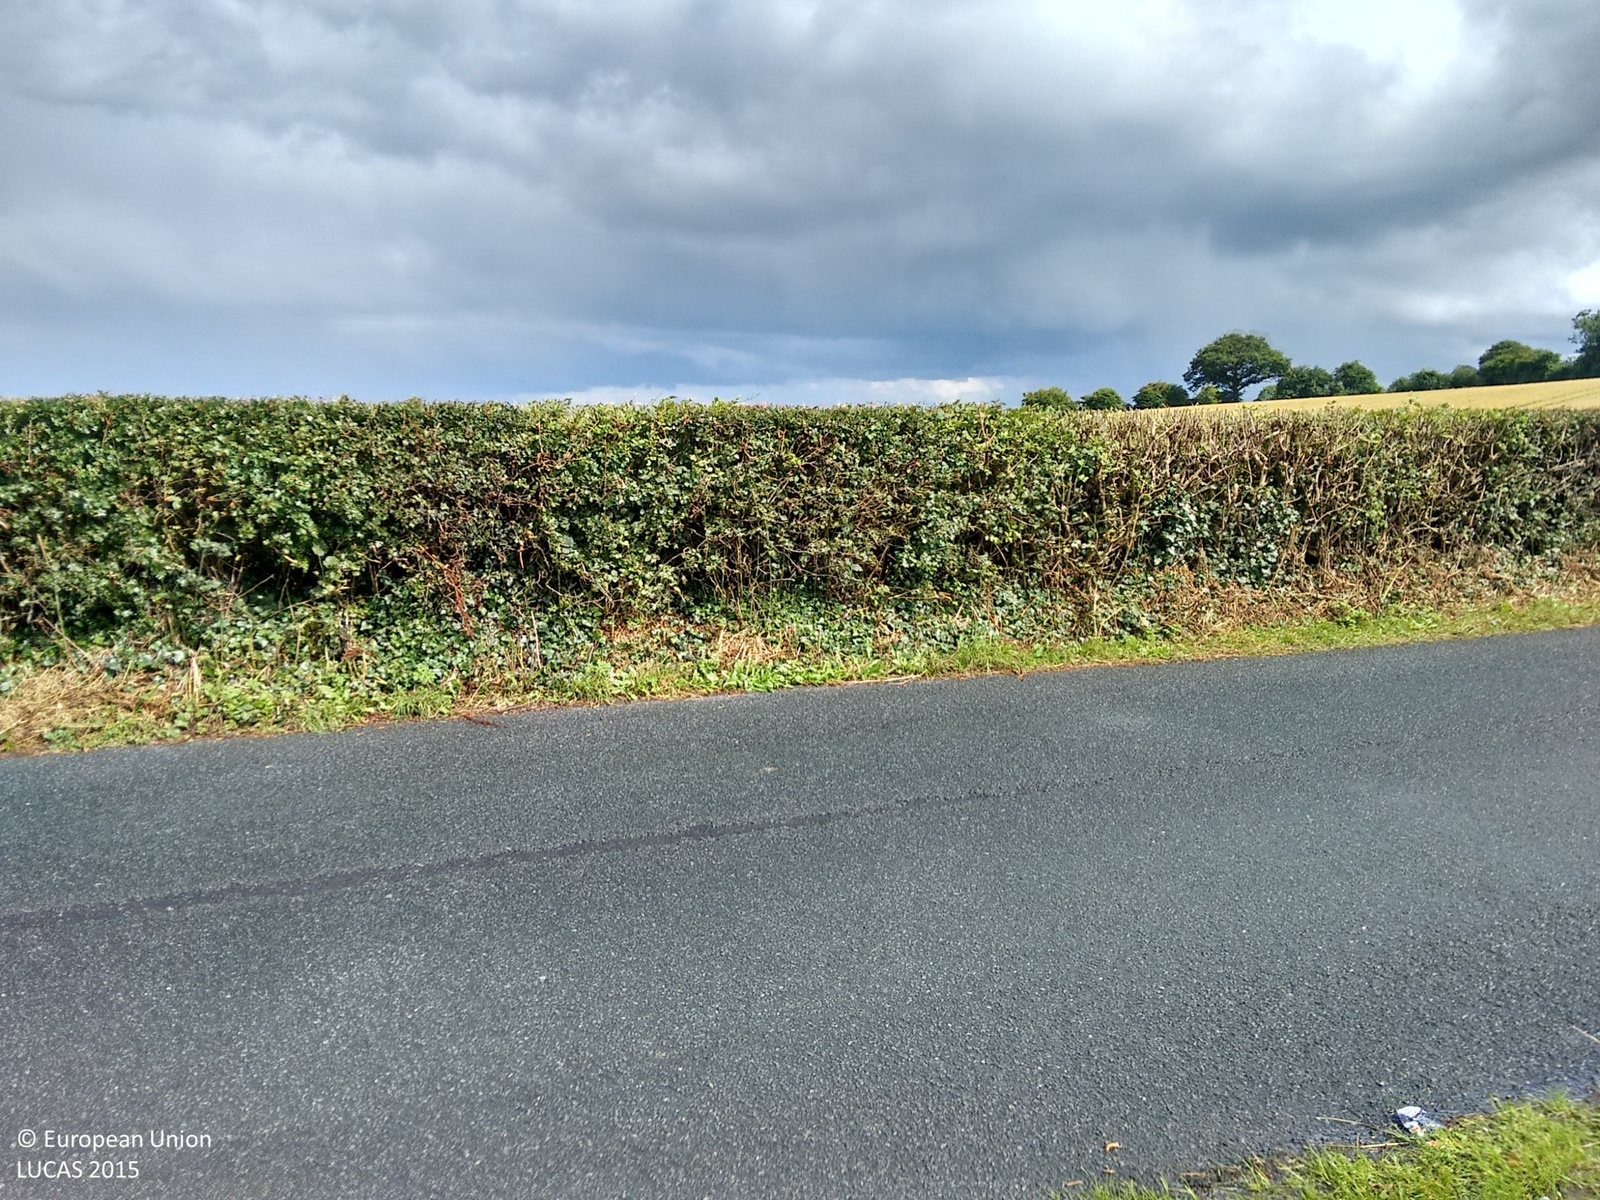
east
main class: Cropland
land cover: Barley
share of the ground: > 75 %
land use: Agriculture (excluding fallow land and kitchen gardens)
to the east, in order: Barley; Managed hedges; Paved roads, cycling and walking lanes; Managed hedges; Common wheat; Abandoned hedges; Common wheat
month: July
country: IE
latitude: 52.7917
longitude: -6.7588
